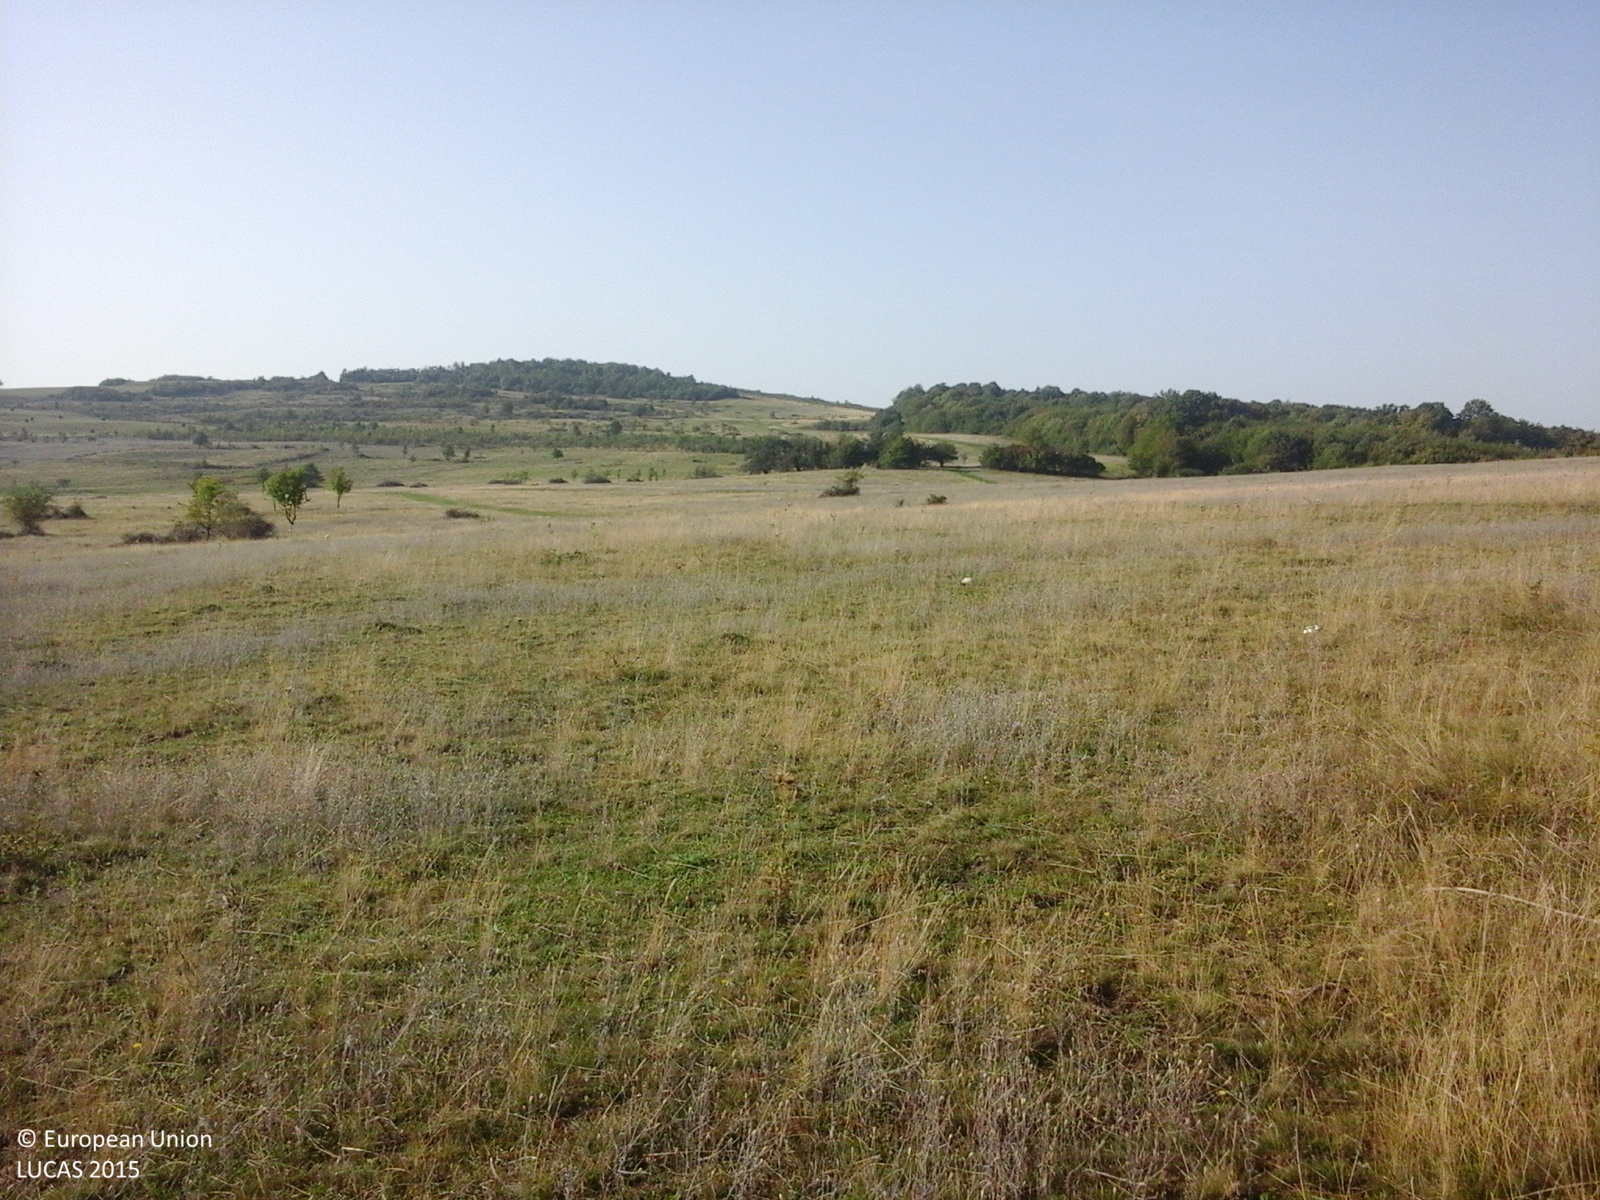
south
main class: Grassland
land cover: Grassland without tree/shrub cover
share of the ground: > 75 %
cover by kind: herbaceous plants 100 %
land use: Agriculture (excluding fallow land and kitchen gardens)
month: September
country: RO
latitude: 47.0530
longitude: 23.6997
